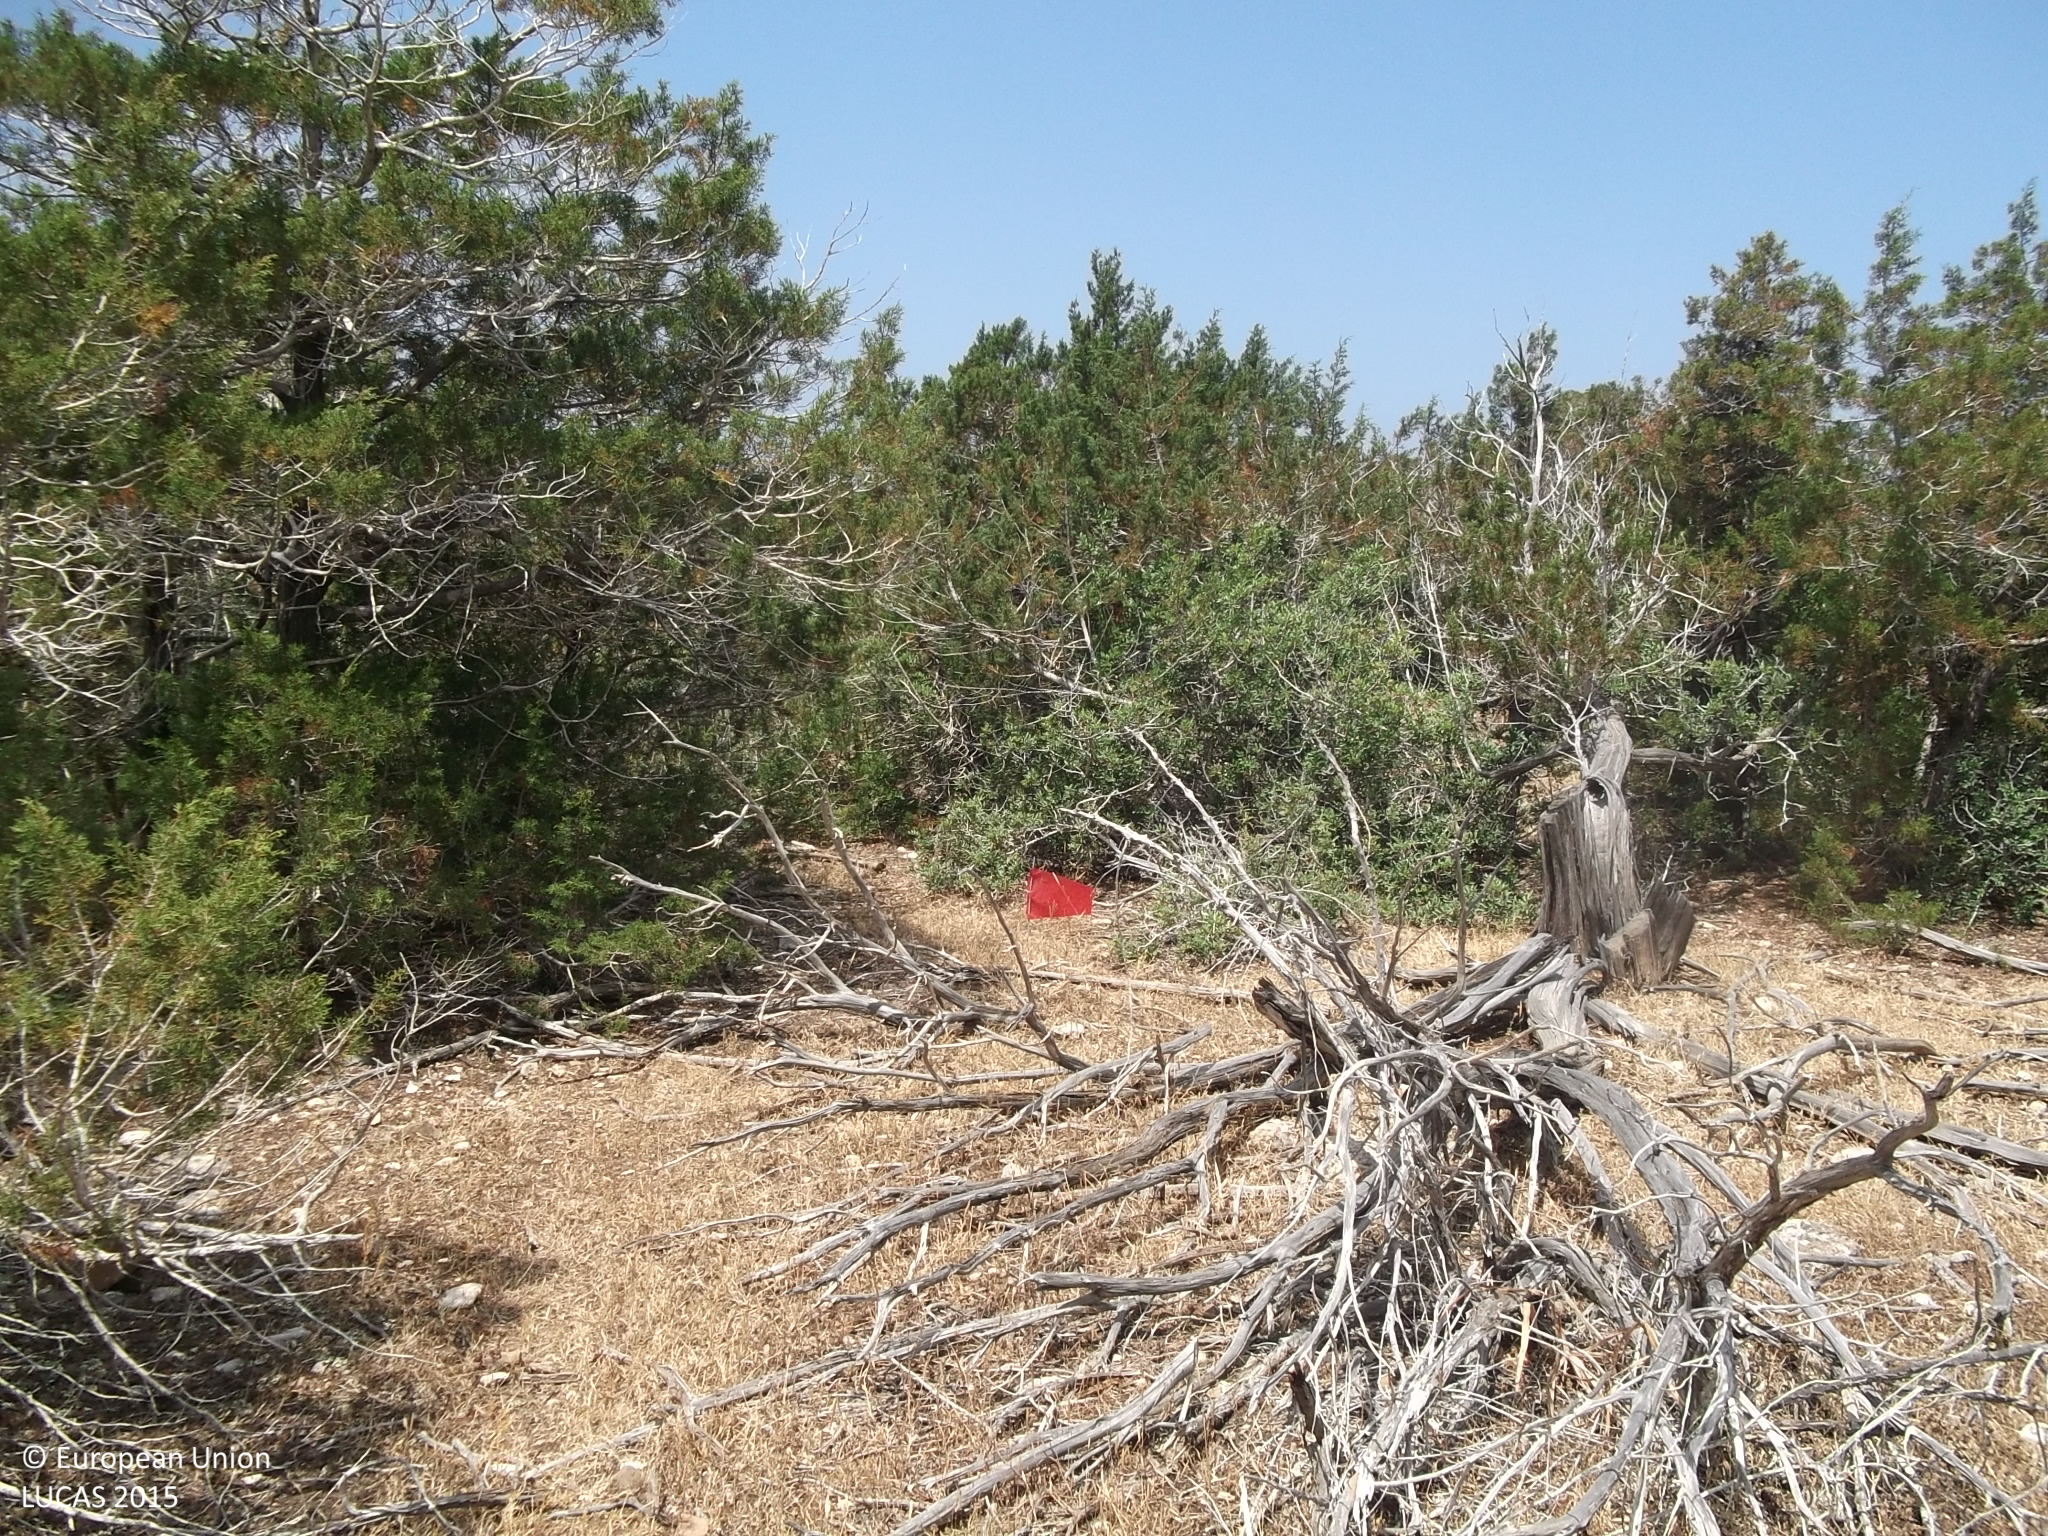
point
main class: Woodland
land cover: Other coniferous woodland
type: coniferous forest of the mediterranean region
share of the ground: > 75 %
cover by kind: coniferous forest trees 100 %
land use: Forestry
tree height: > 5 m
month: May
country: CY
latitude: 35.0490
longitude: 32.2835
